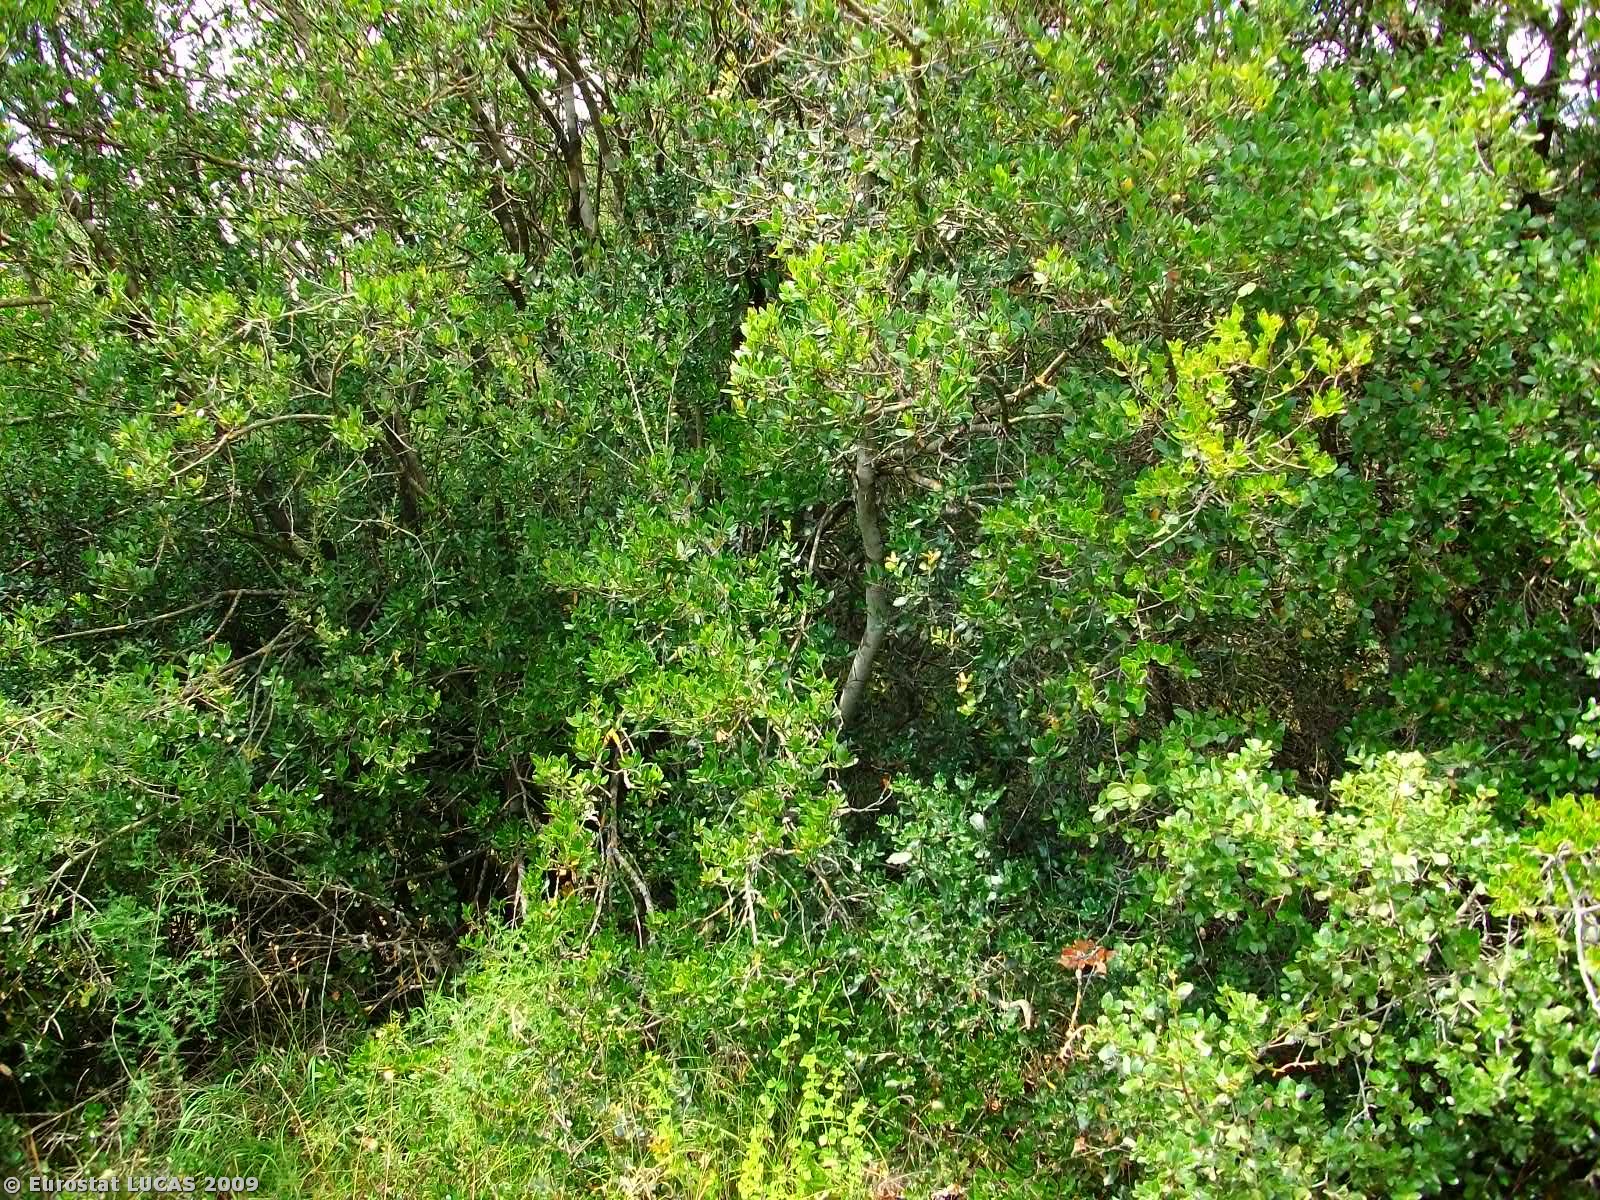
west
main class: Woodland
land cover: Broadleaved woodland
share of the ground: > 75 %
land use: Forestry
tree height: < 5 m
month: June
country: GR
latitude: 38.8570
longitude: 21.5084
